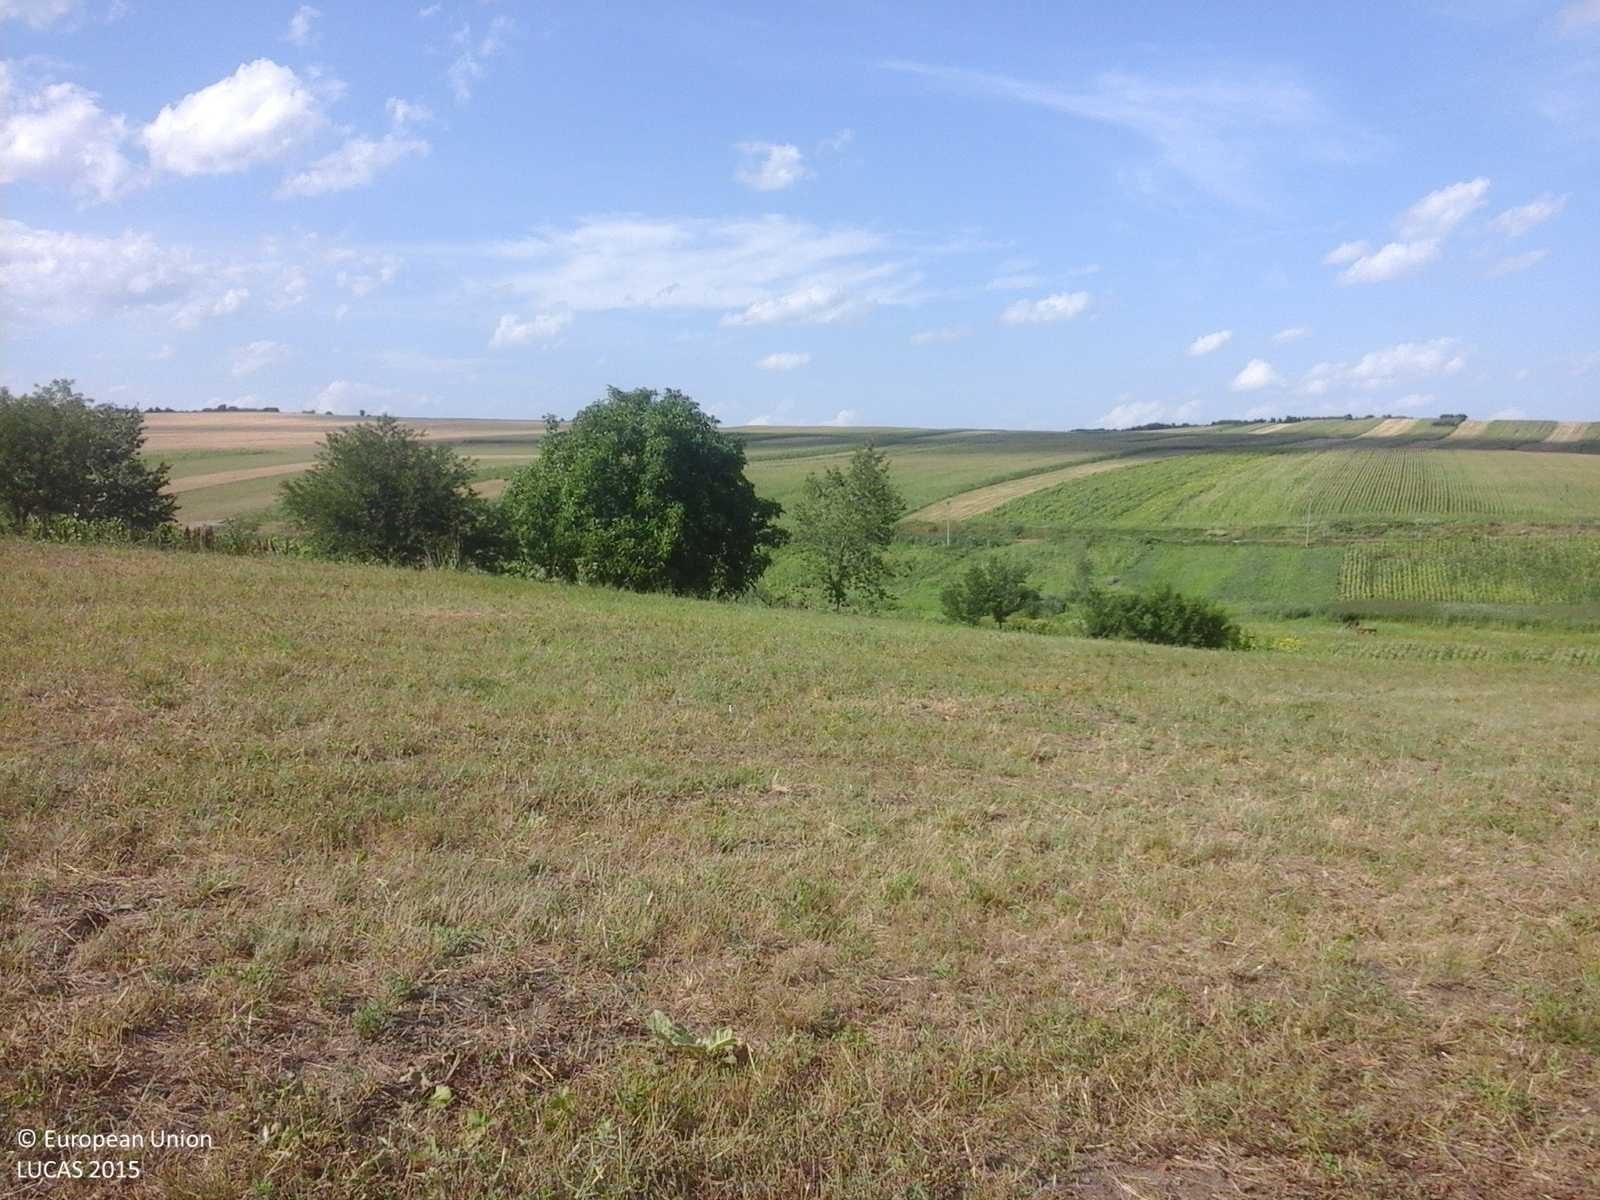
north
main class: Cropland
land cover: Lucerne
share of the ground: > 75 %
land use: Agriculture (excluding fallow land and kitchen gardens)
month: July
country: RO
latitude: 46.5943
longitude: 27.3497
